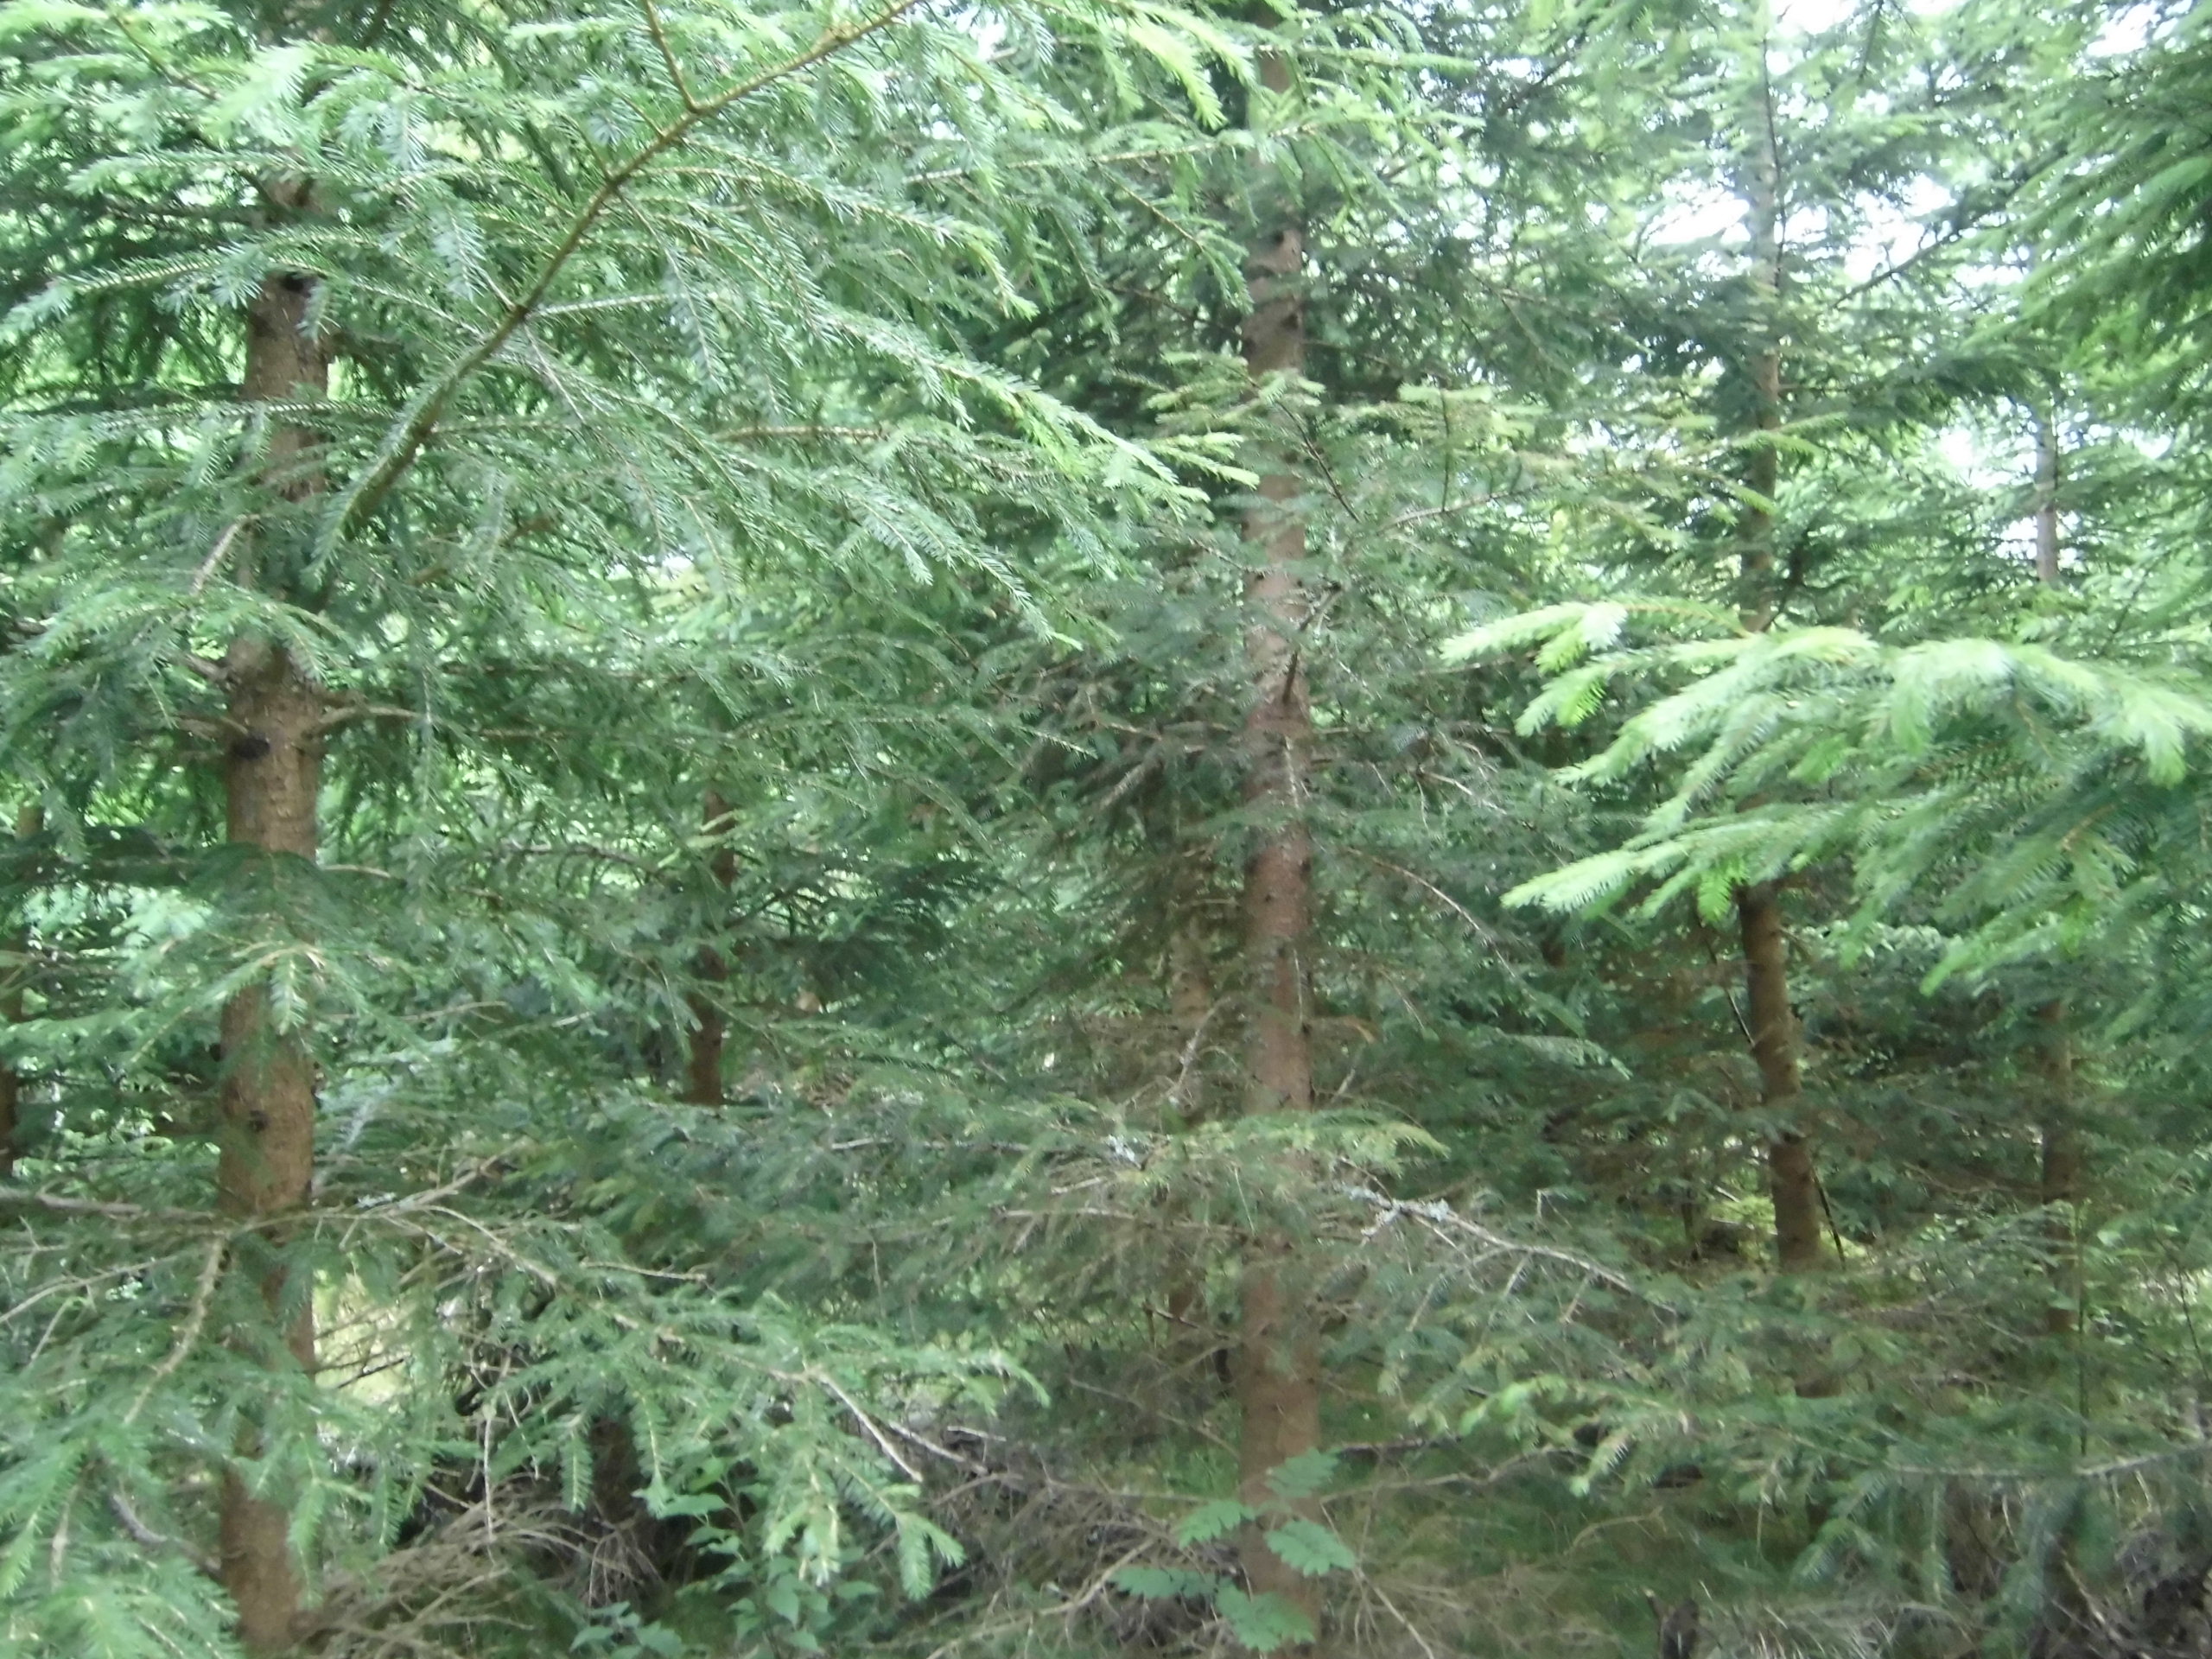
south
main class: Woodland
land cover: Spruce dominated coniferous woodland
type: boreal forest
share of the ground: 50 - 75 %
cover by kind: coniferous forest trees 60 %, herbaceous plants 15 %, broadleaved forest trees 10 %, lichens and mosses 10 %, shrubs 5 %
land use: Forestry
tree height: > 5 m
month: July
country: SE
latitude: 57.4690
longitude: 14.7477
